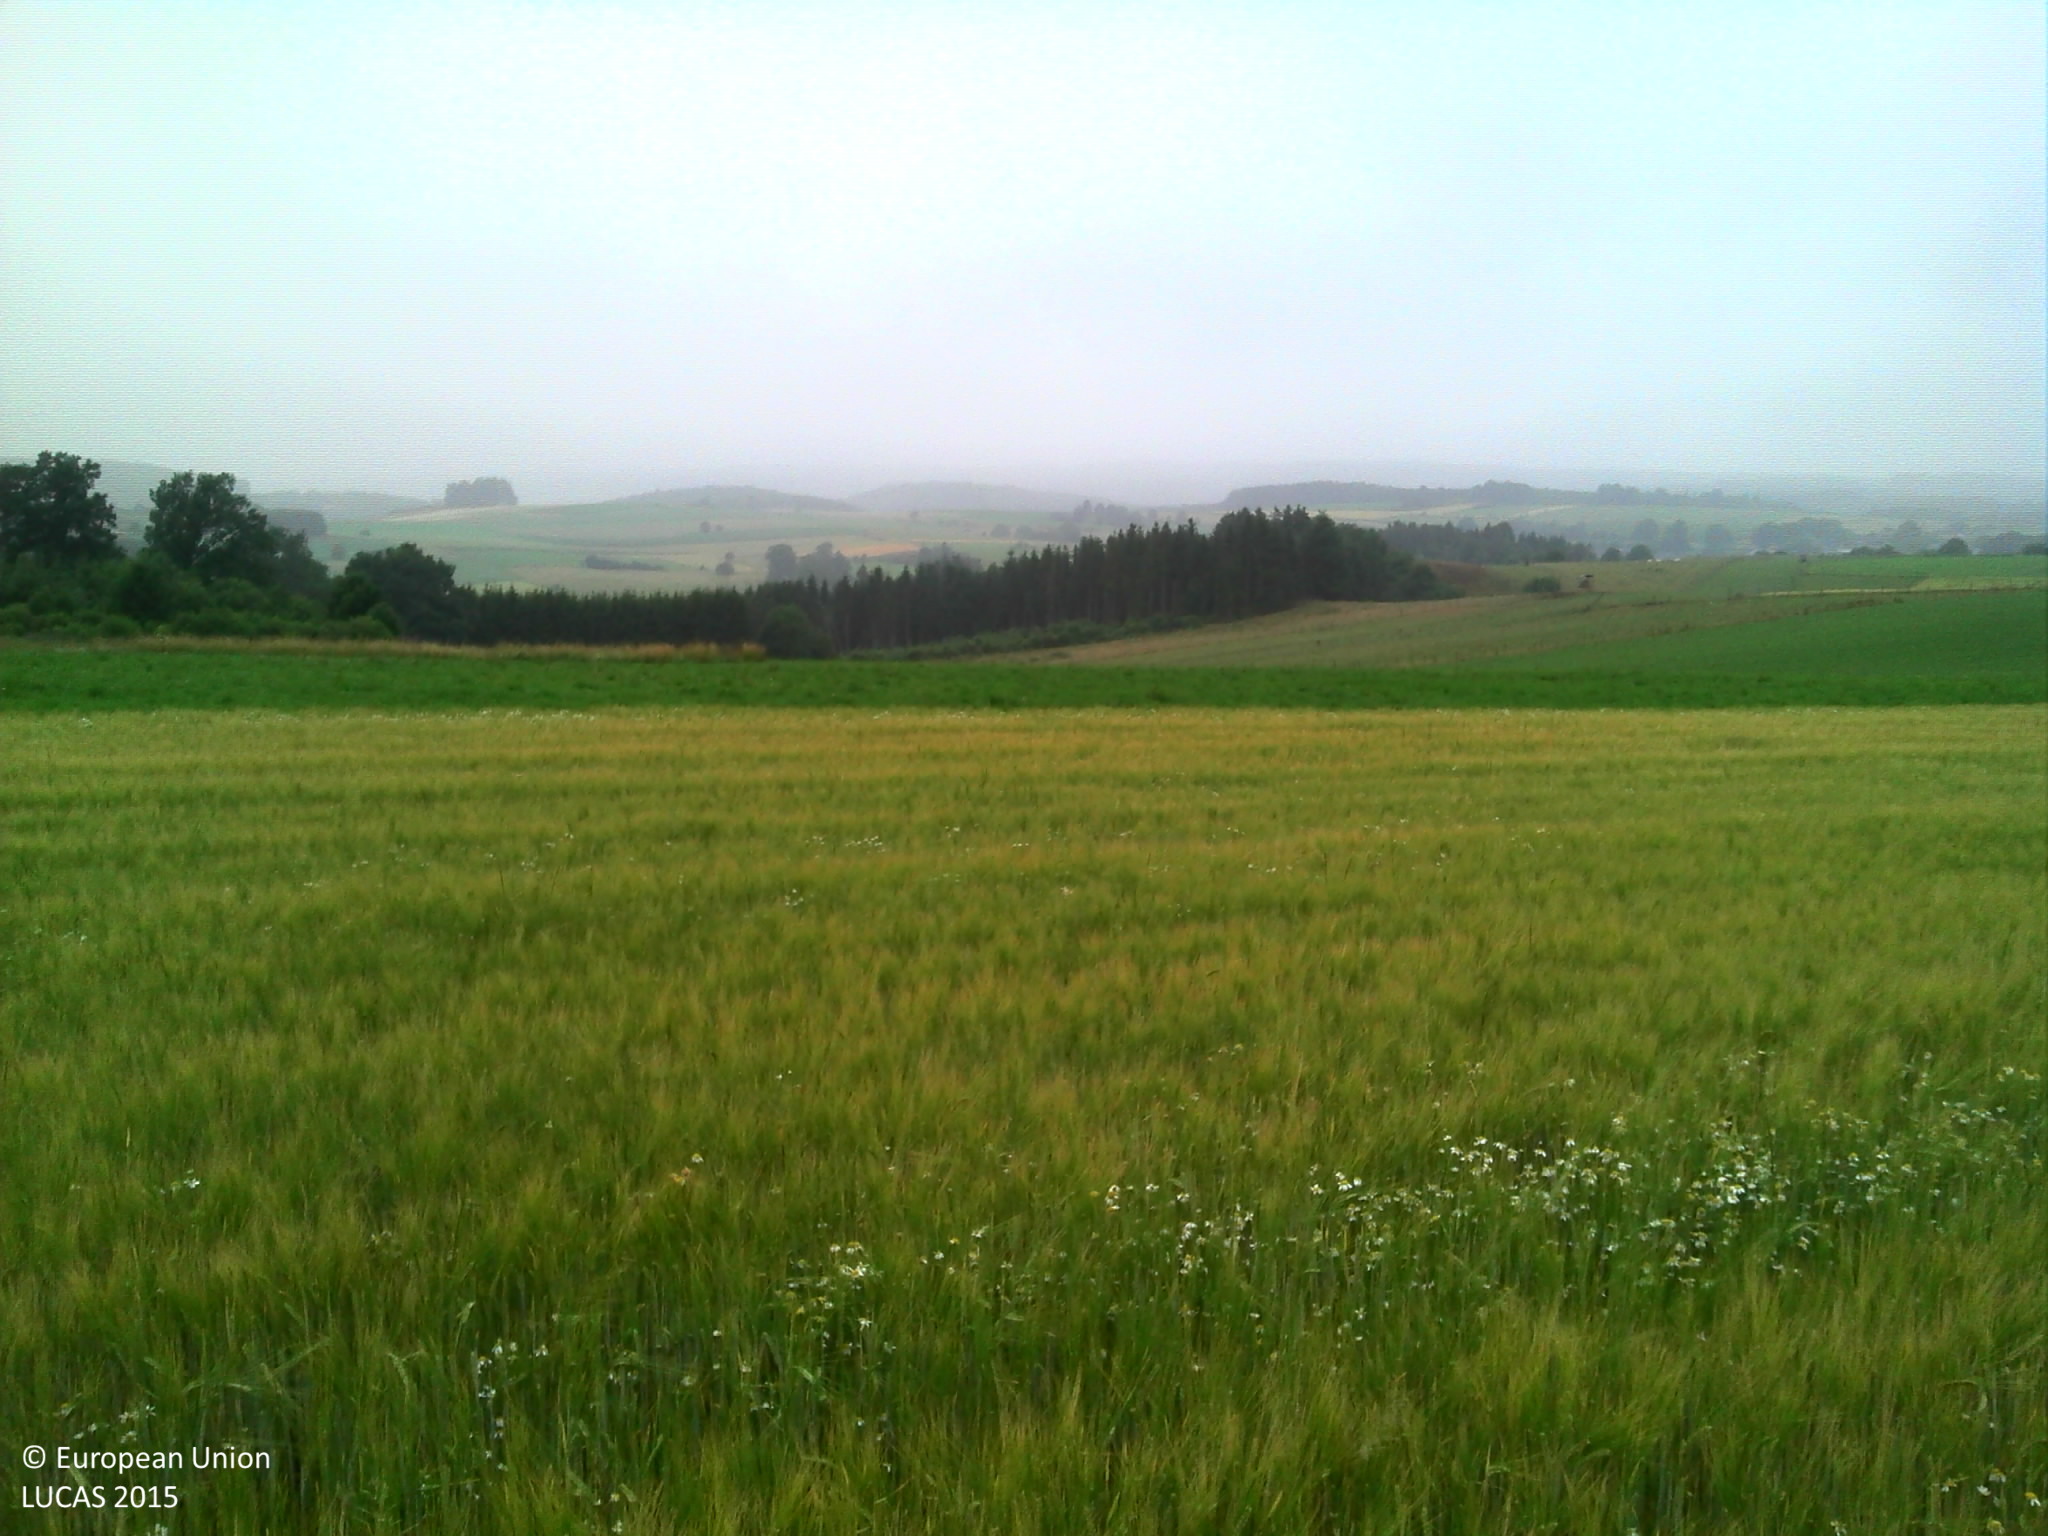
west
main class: Cropland
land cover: Barley
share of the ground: > 75 %
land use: Agriculture (excluding fallow land and kitchen gardens)
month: July
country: BE
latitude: 50.0654
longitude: 5.6539
